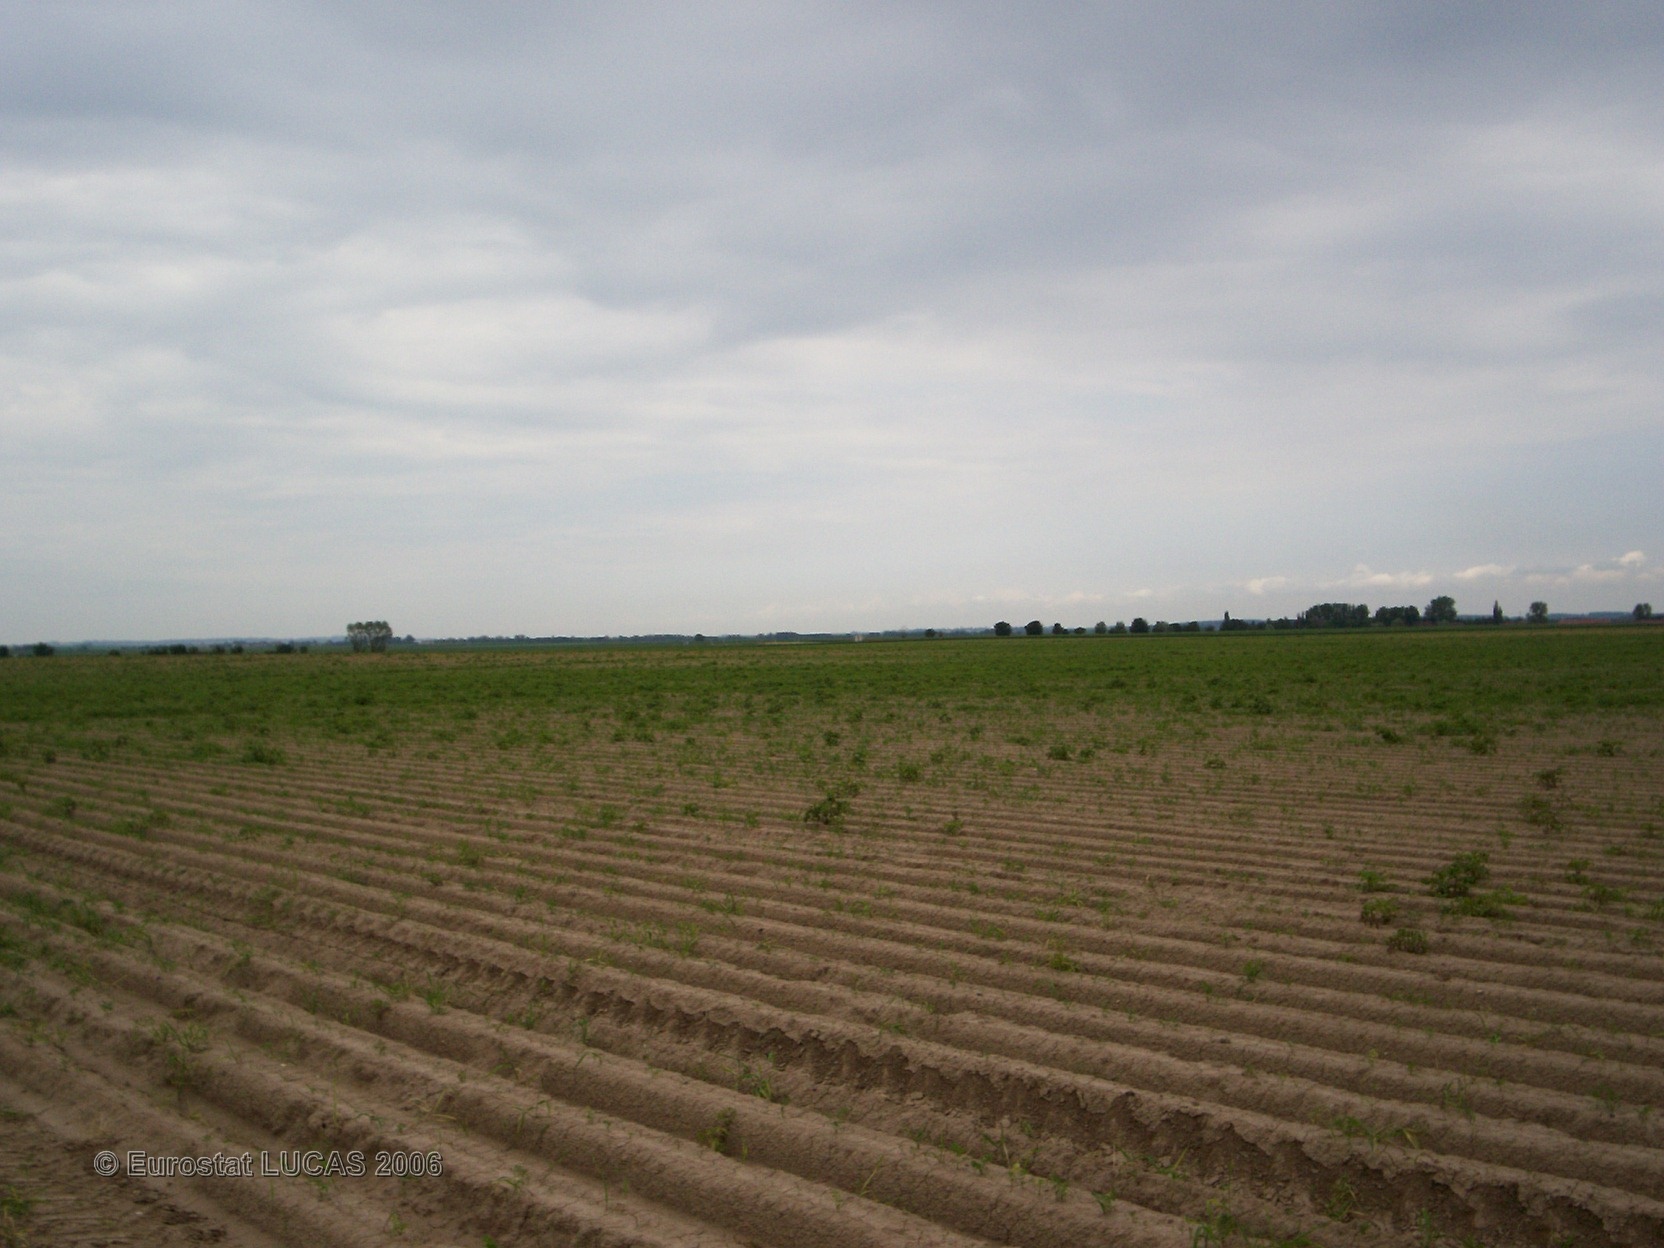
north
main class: Cropland
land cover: Other fresh vegetables
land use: Agriculture (excluding fallow land and kitchen gardens)
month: June
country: FR
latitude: 49.4601
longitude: 2.6628
